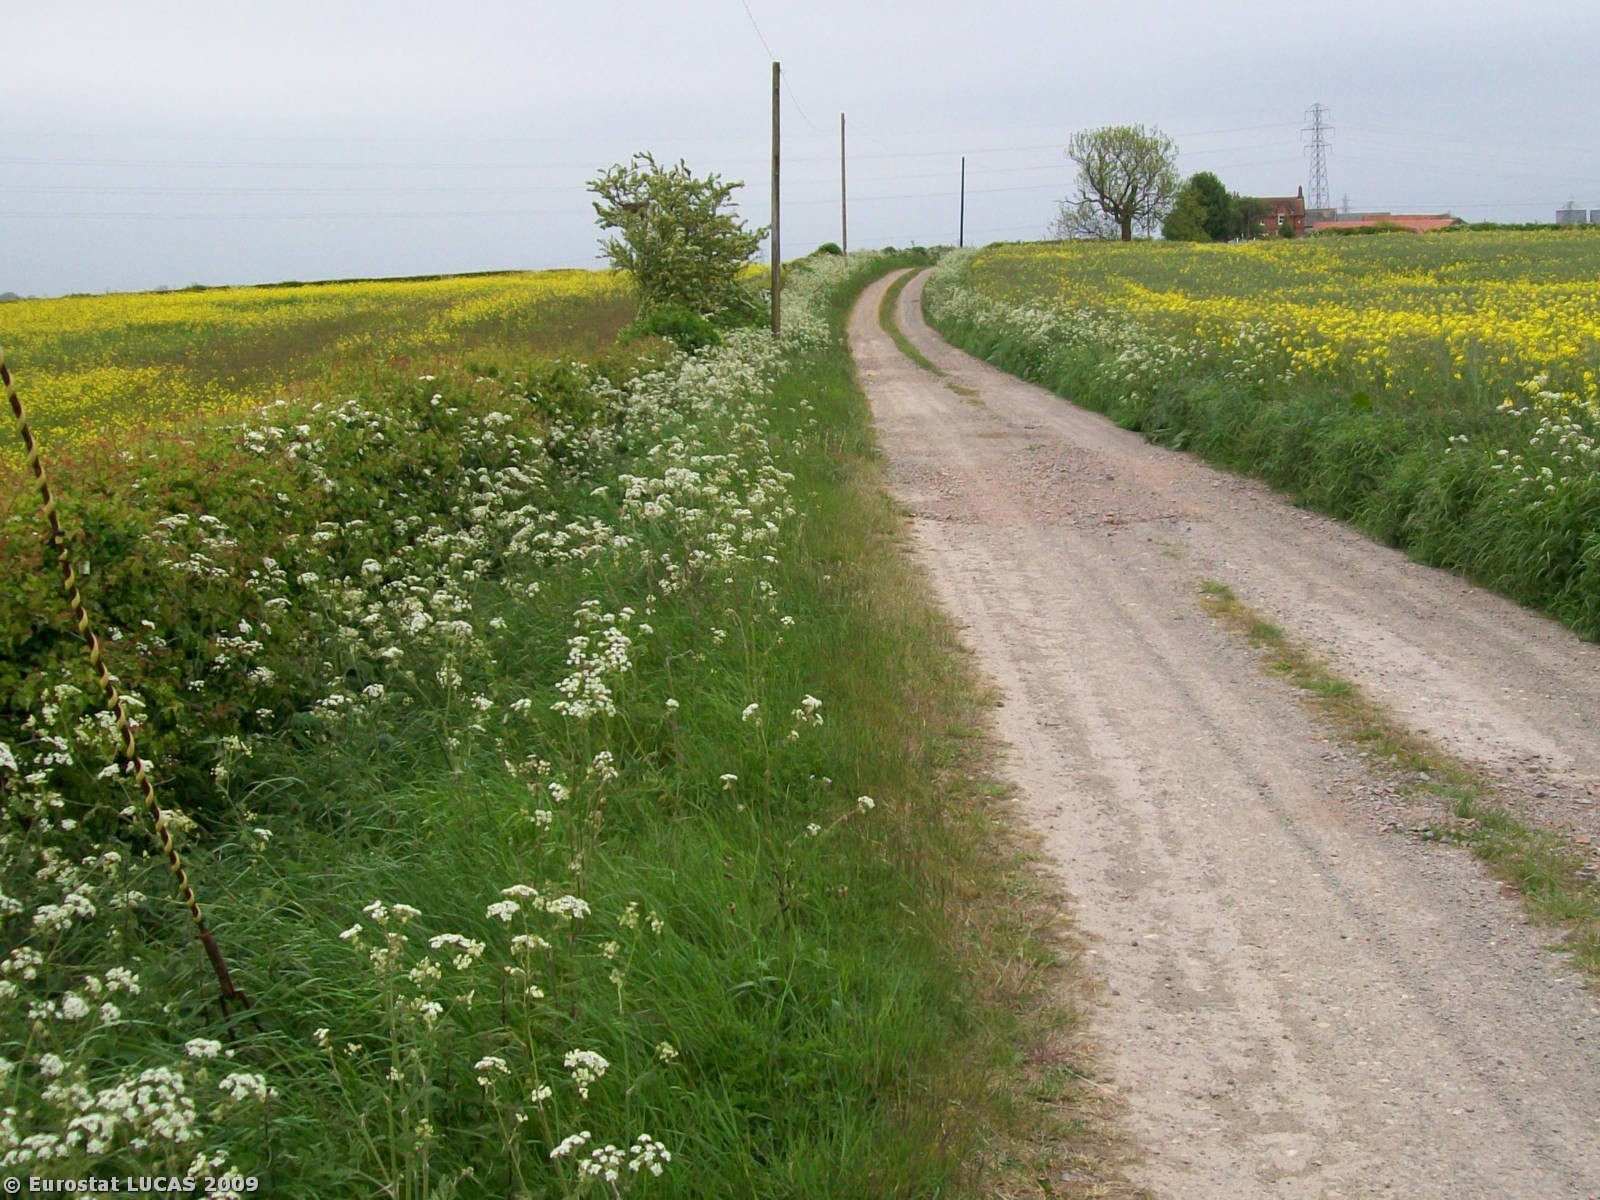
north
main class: Cropland
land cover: Rape and turnip rape
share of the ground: > 75 %
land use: Agriculture (excluding fallow land and kitchen gardens)
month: May
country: GB
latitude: 52.7680
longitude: -0.8467
